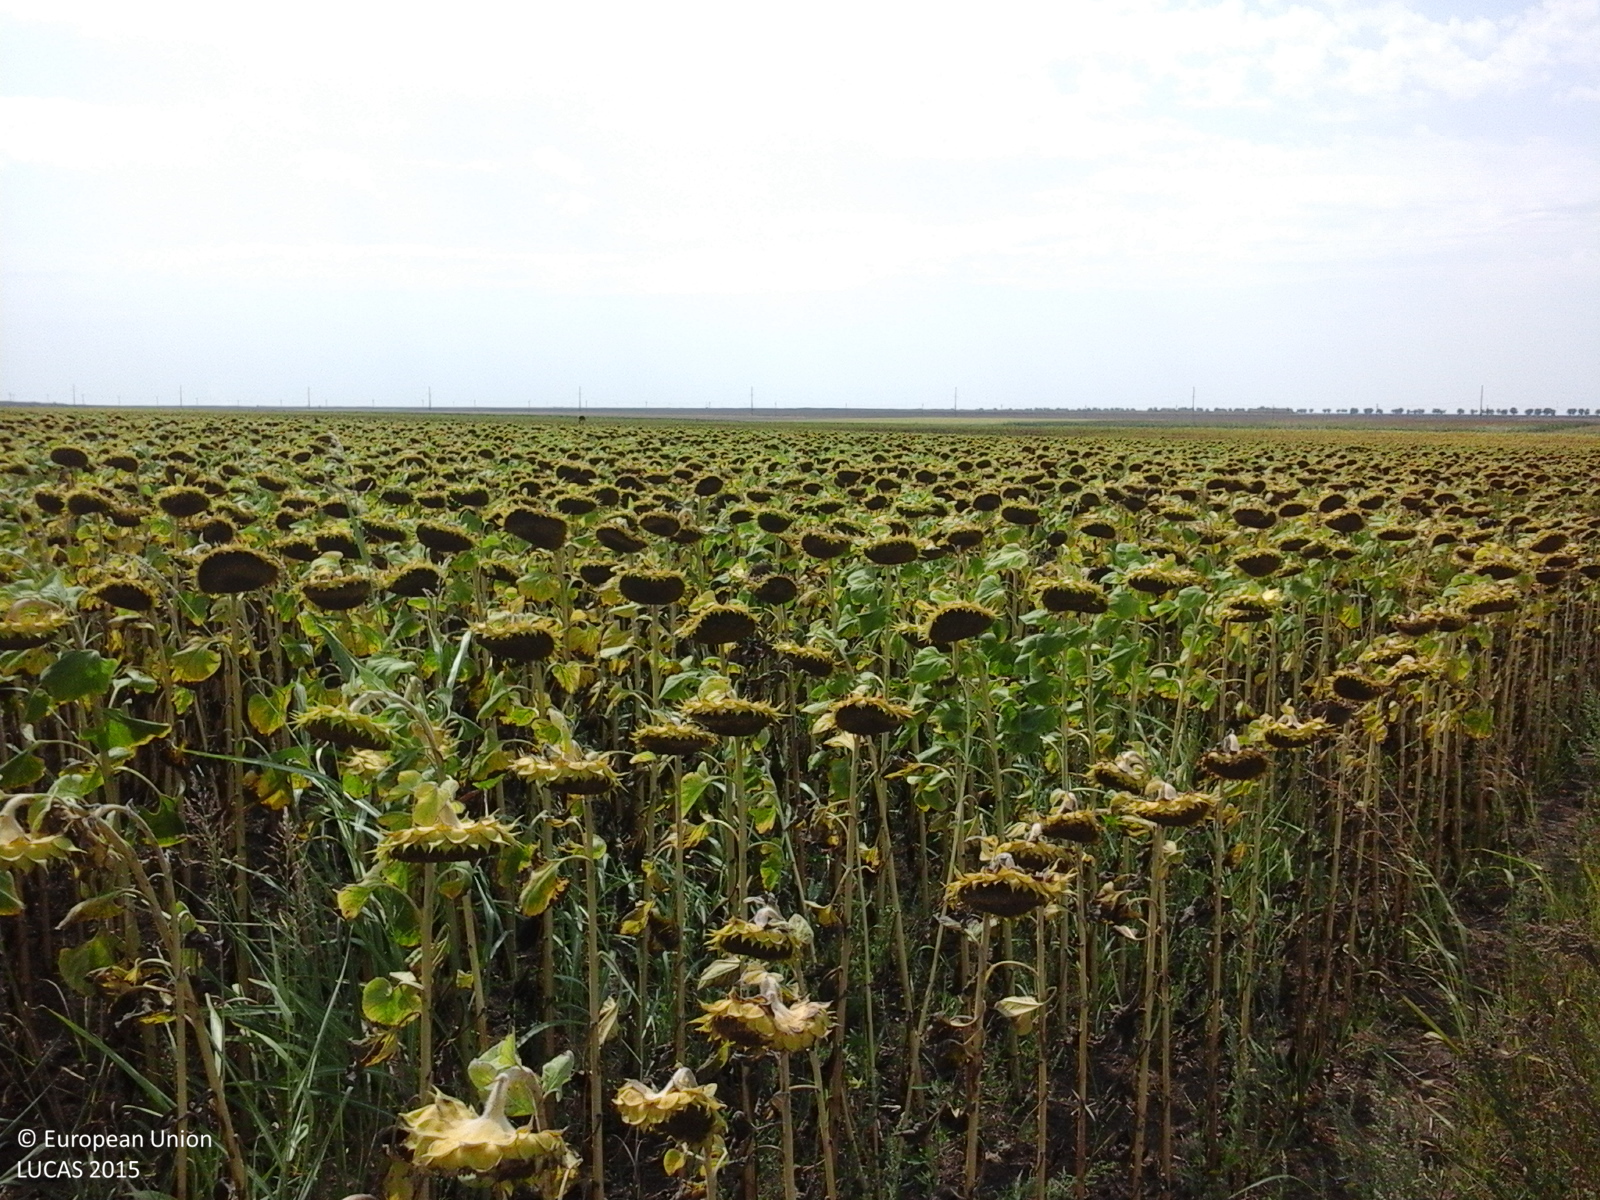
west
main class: Cropland
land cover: Sunflower
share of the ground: > 75 %
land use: Agriculture (excluding fallow land and kitchen gardens)
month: August
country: RO
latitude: 43.9098
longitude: 28.3799
